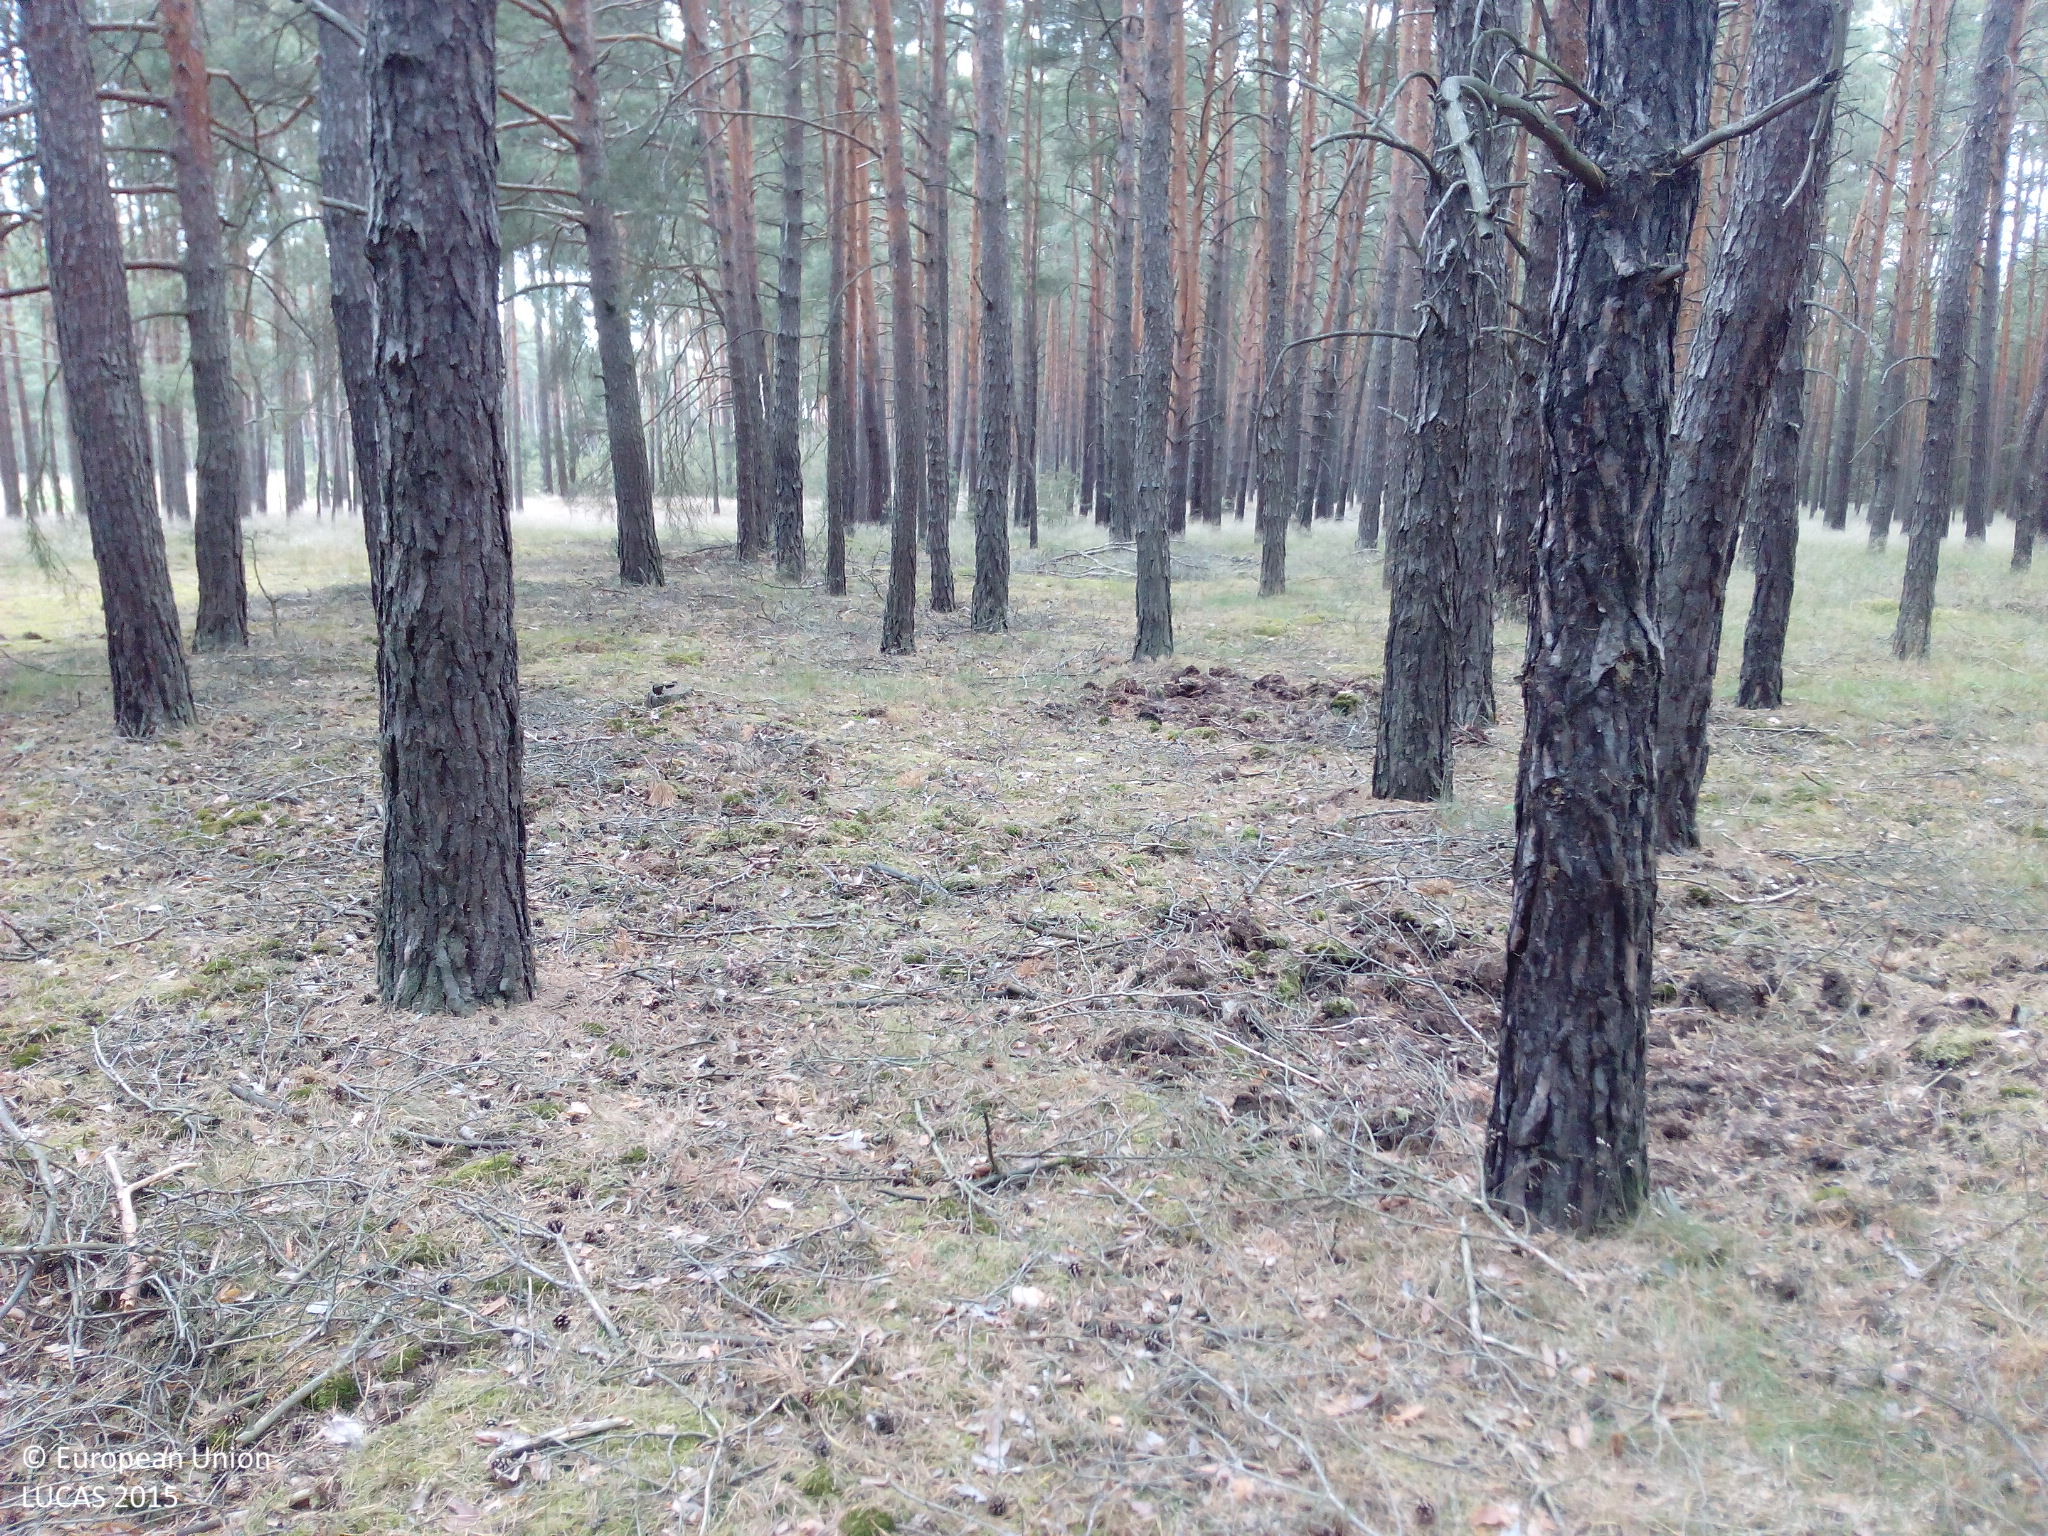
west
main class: Woodland
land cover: Pine dominated coniferous woodland
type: hemiboreal forest and nemoral coniferous forest and mixed broadleaved-coniferous forest
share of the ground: > 75 %
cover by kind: coniferous forest trees 90 %, lichens and mosses 5 %, unconsolidated bare surface 5 %
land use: Forestry
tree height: > 5 m
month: June
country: DE
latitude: 52.2809
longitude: 12.4182
